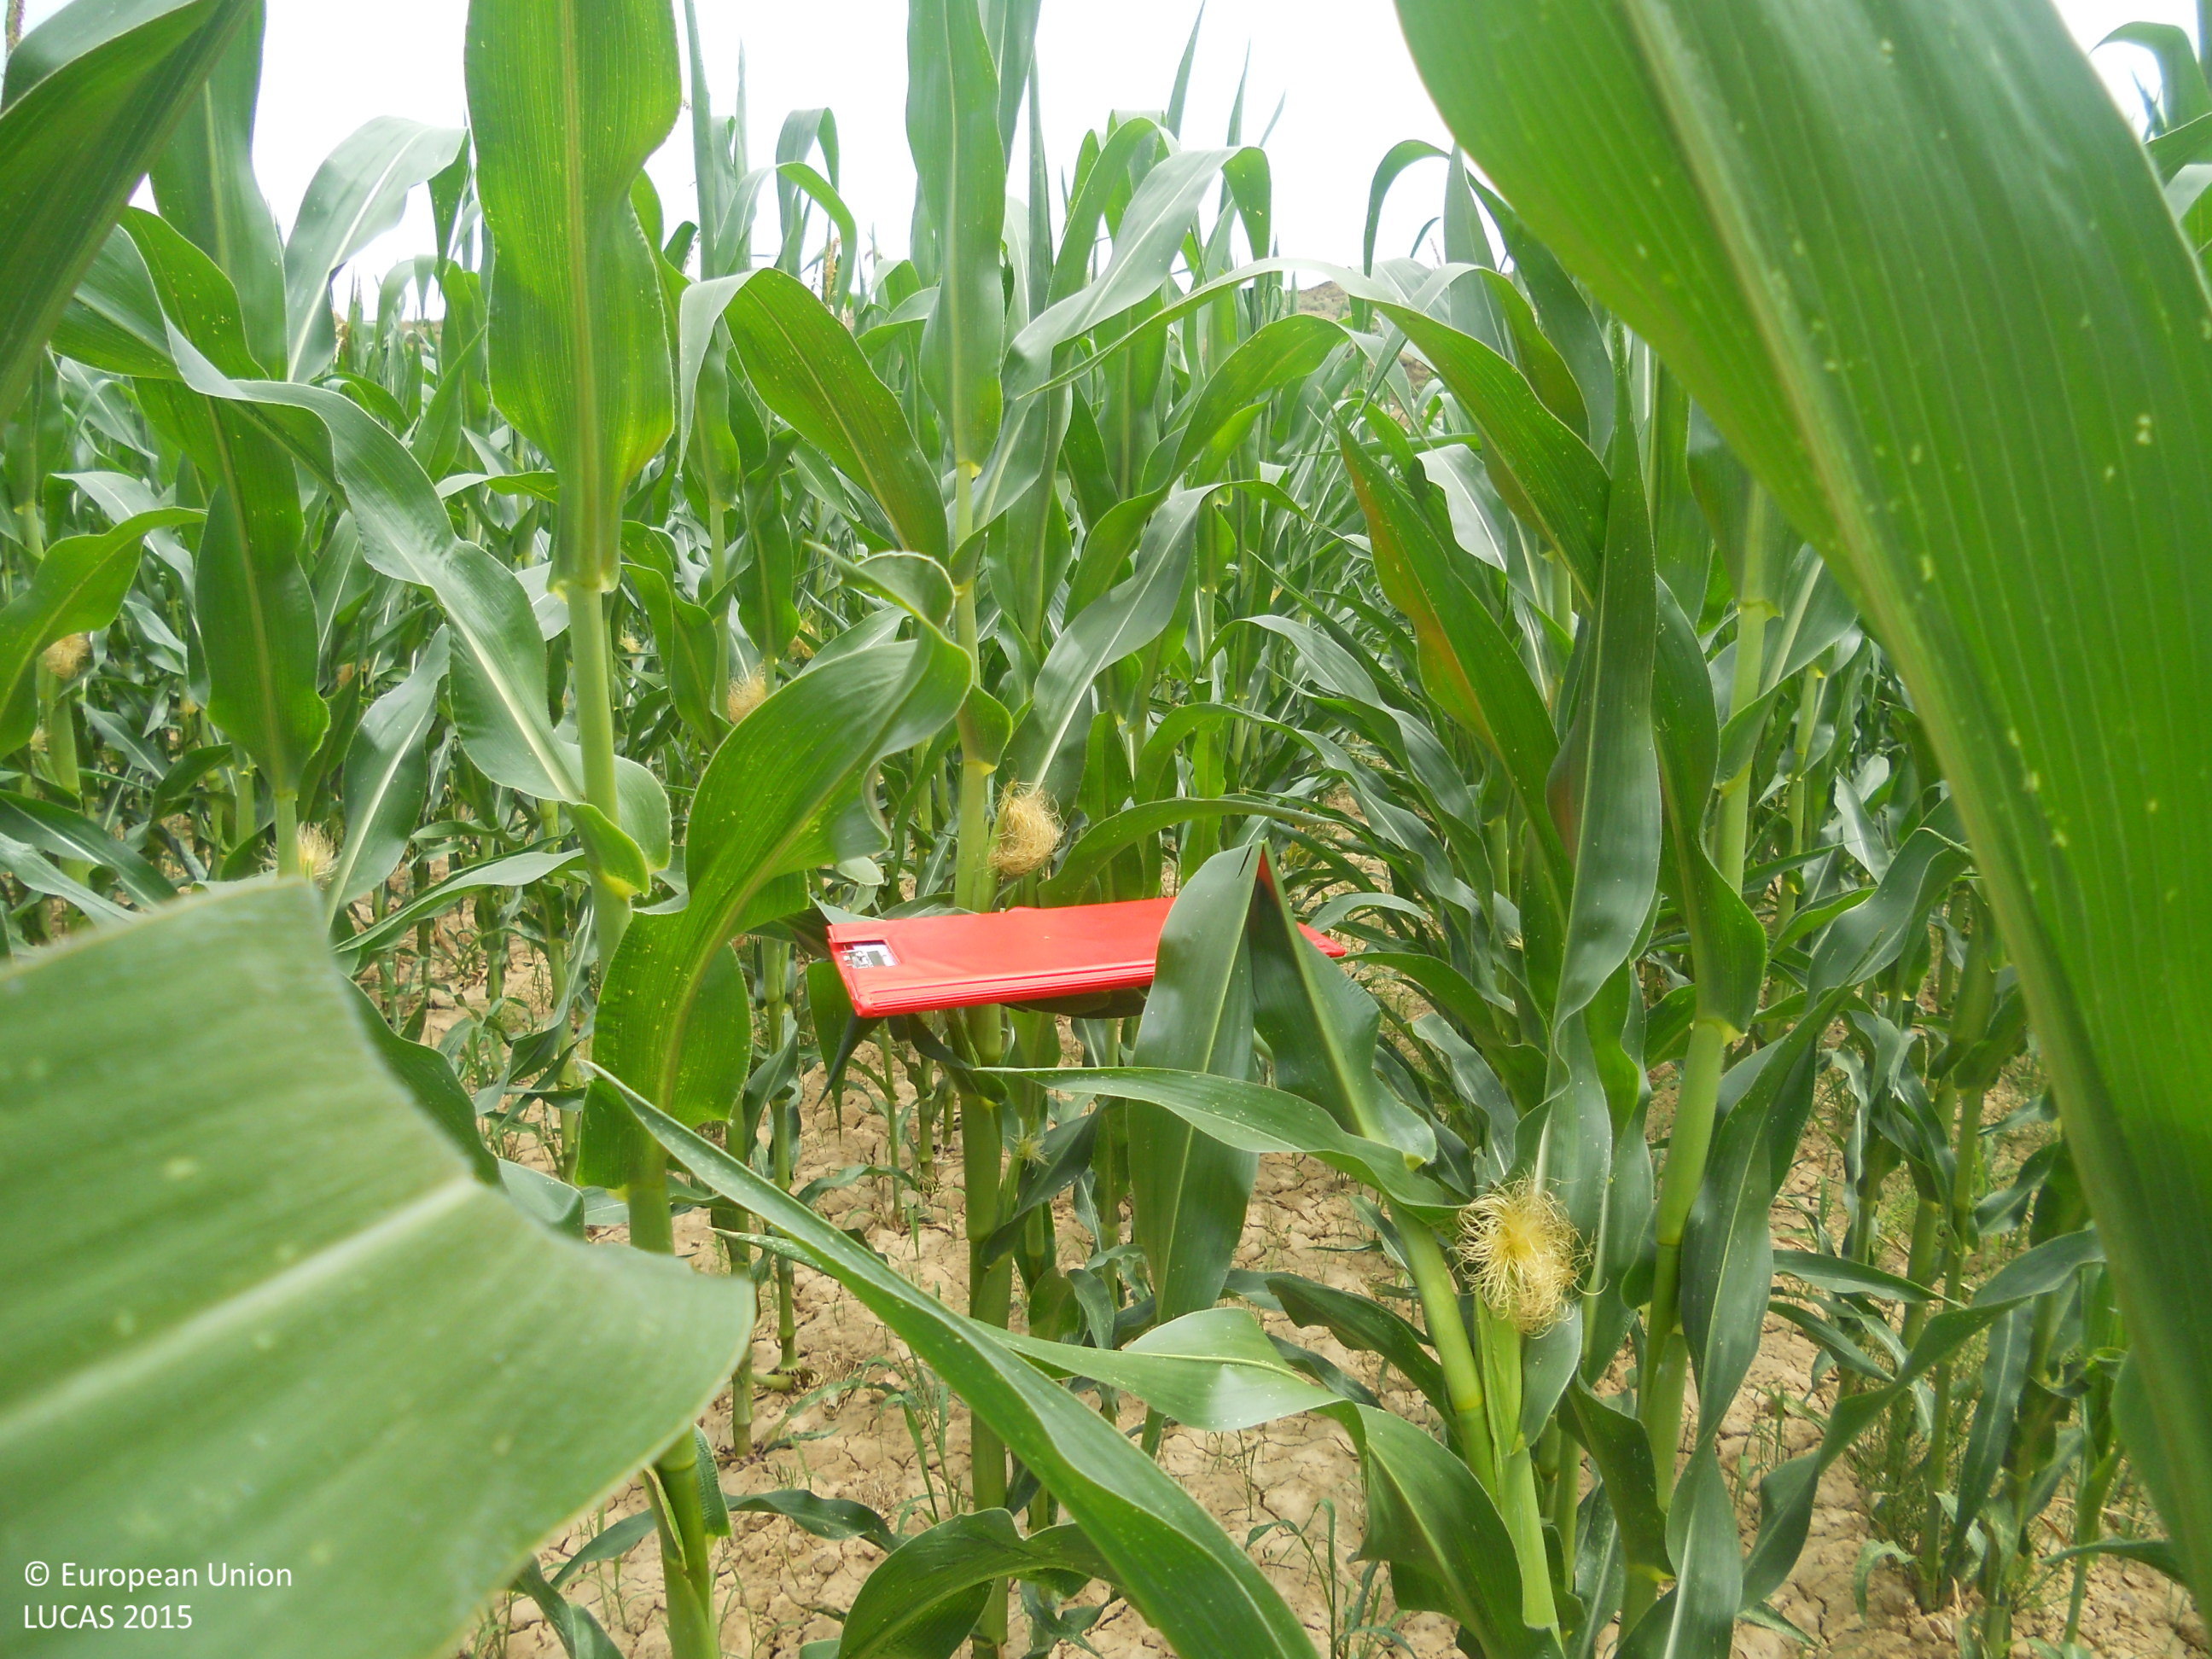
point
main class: Cropland
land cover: Maize
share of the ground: > 75 %
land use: Agriculture (excluding fallow land and kitchen gardens)
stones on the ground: < 10 %
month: July
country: ES
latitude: 42.5469
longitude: -5.4251
